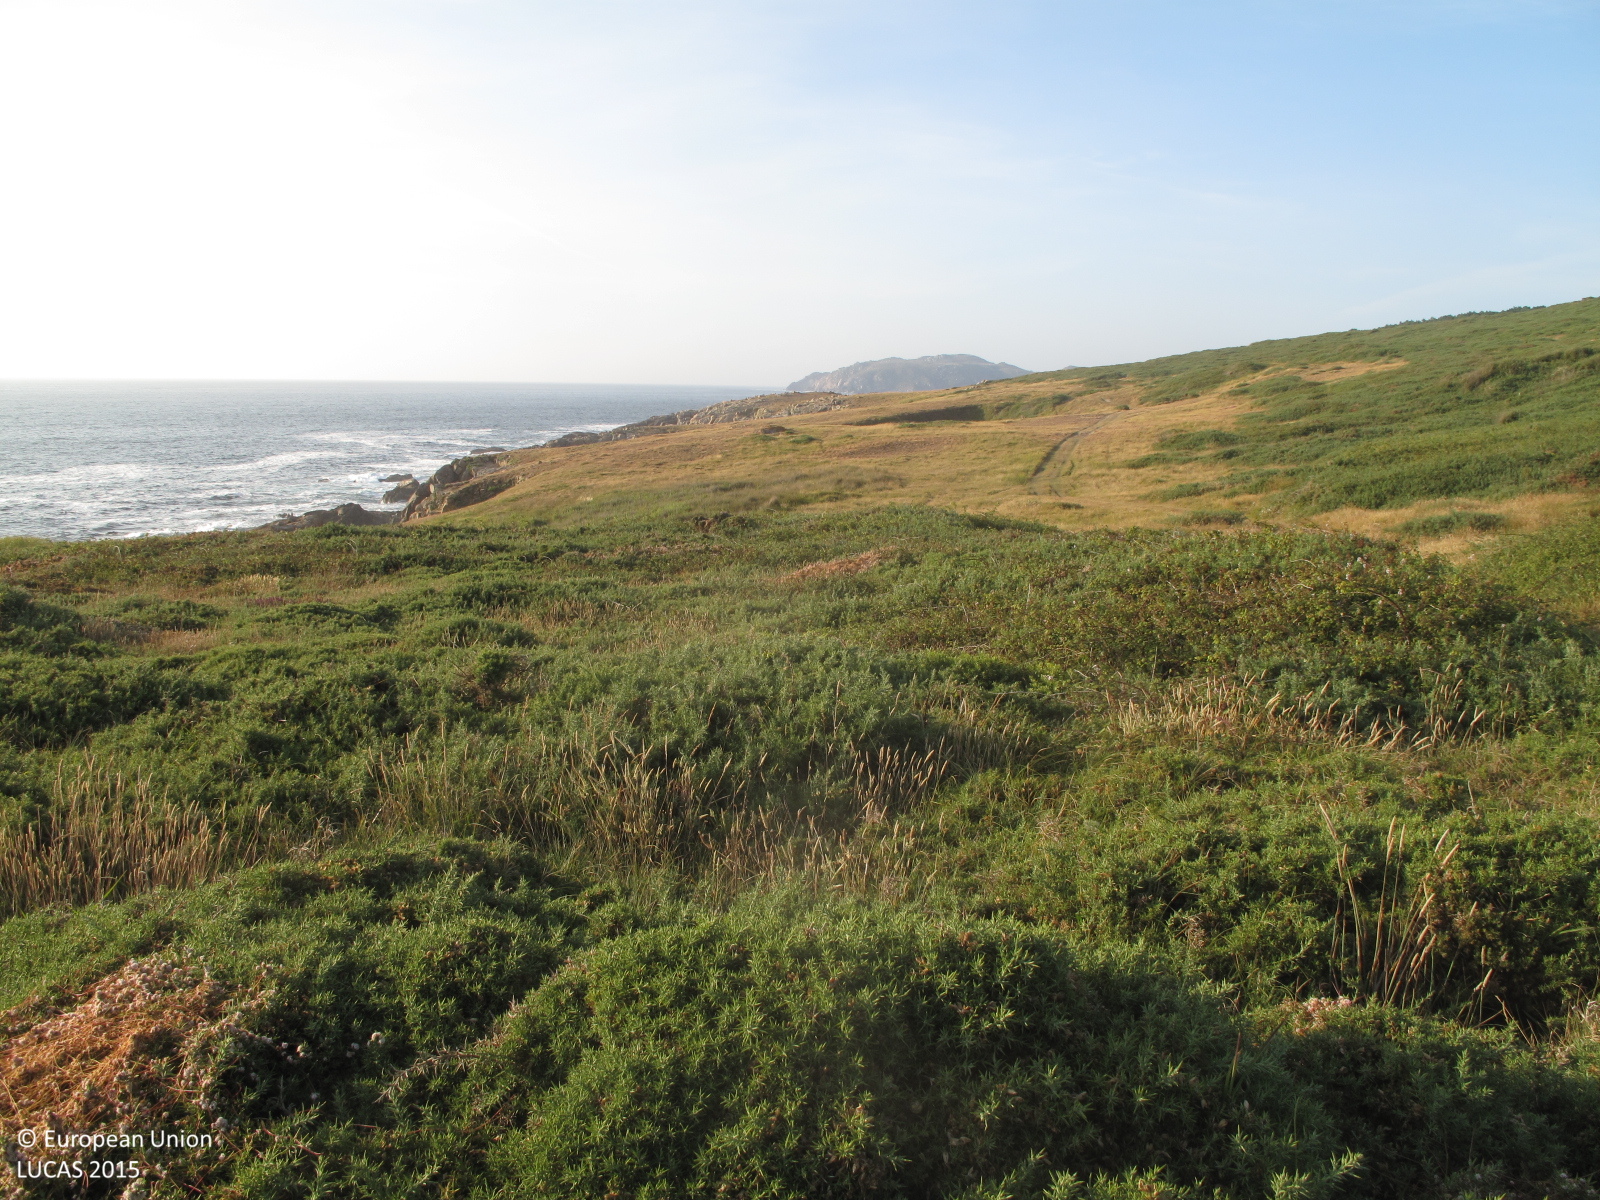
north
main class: Shrubland
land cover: Shrubland without tree cover
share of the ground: > 75 %
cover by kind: shrubs 100 %
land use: Semi-natural and natural areas not in use
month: July
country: ES
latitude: 43.5132
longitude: -8.3275
